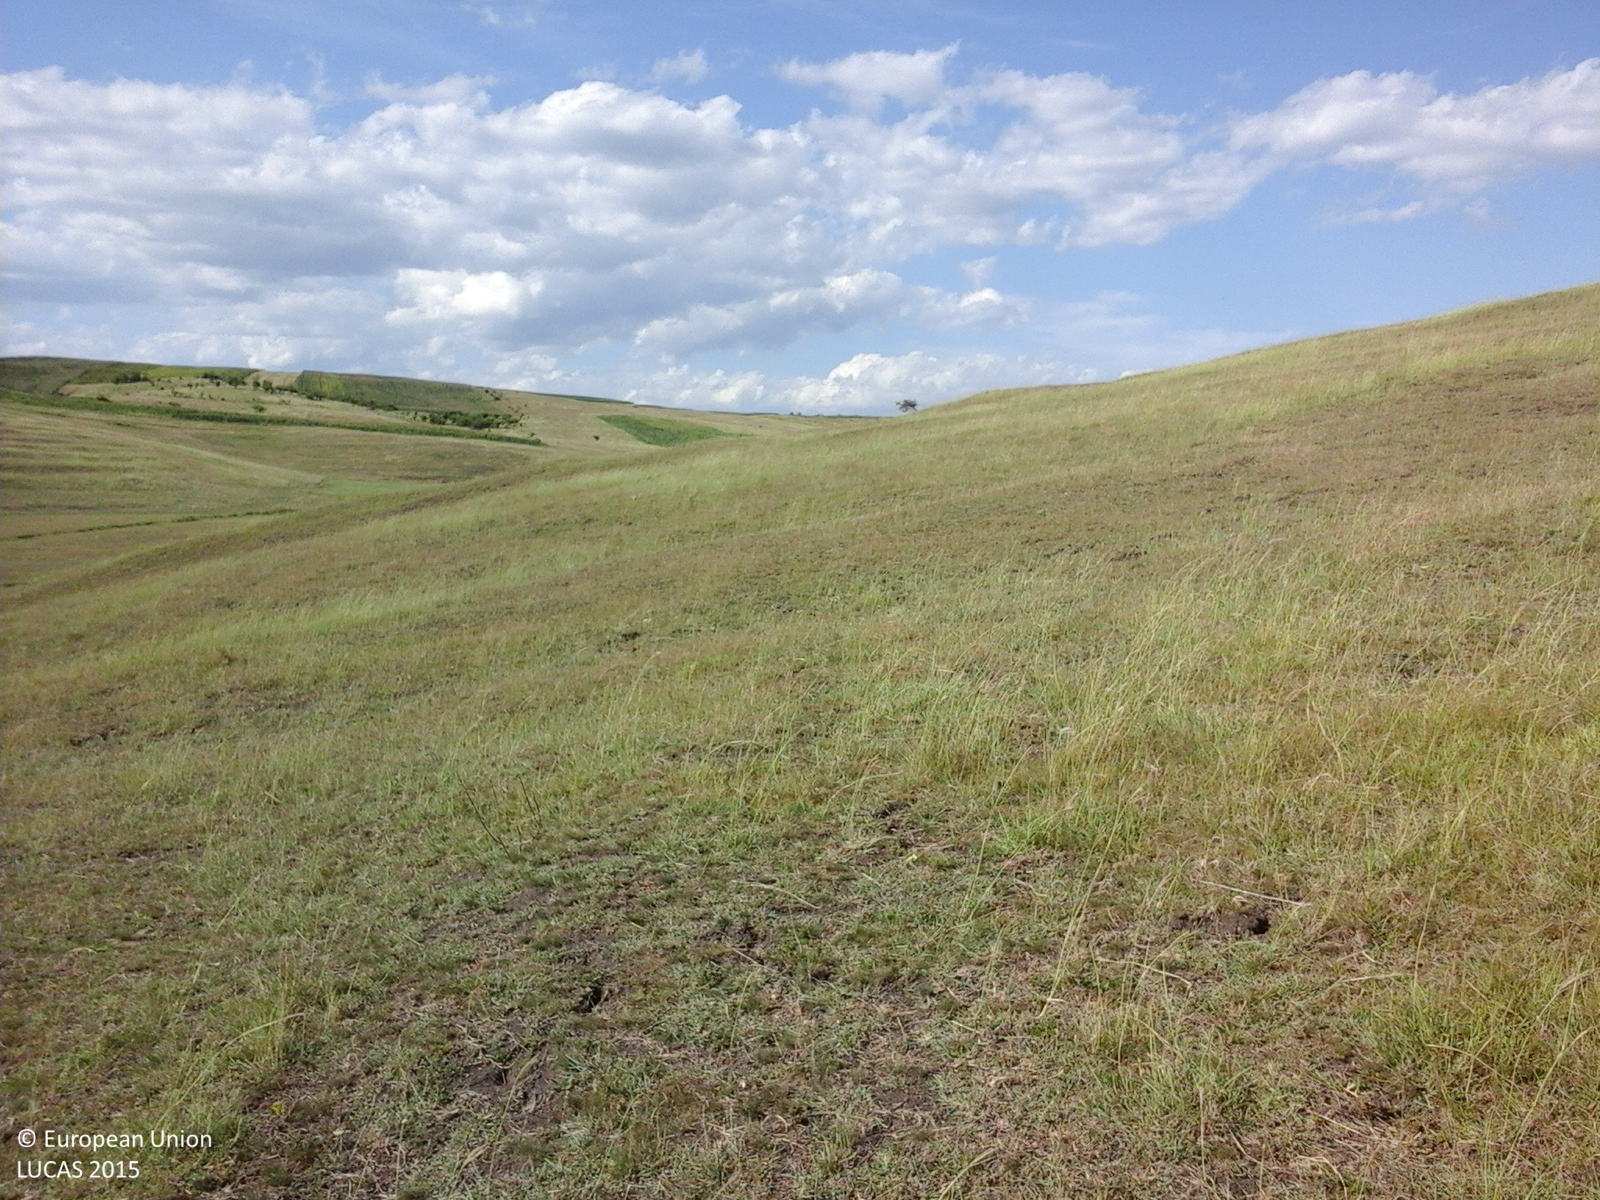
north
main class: Grassland
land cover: Grassland without tree/shrub cover
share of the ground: > 75 %
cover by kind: herbaceous plants 100 %
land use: Agriculture (excluding fallow land and kitchen gardens)
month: July
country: RO
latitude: 46.0258
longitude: 27.6682
